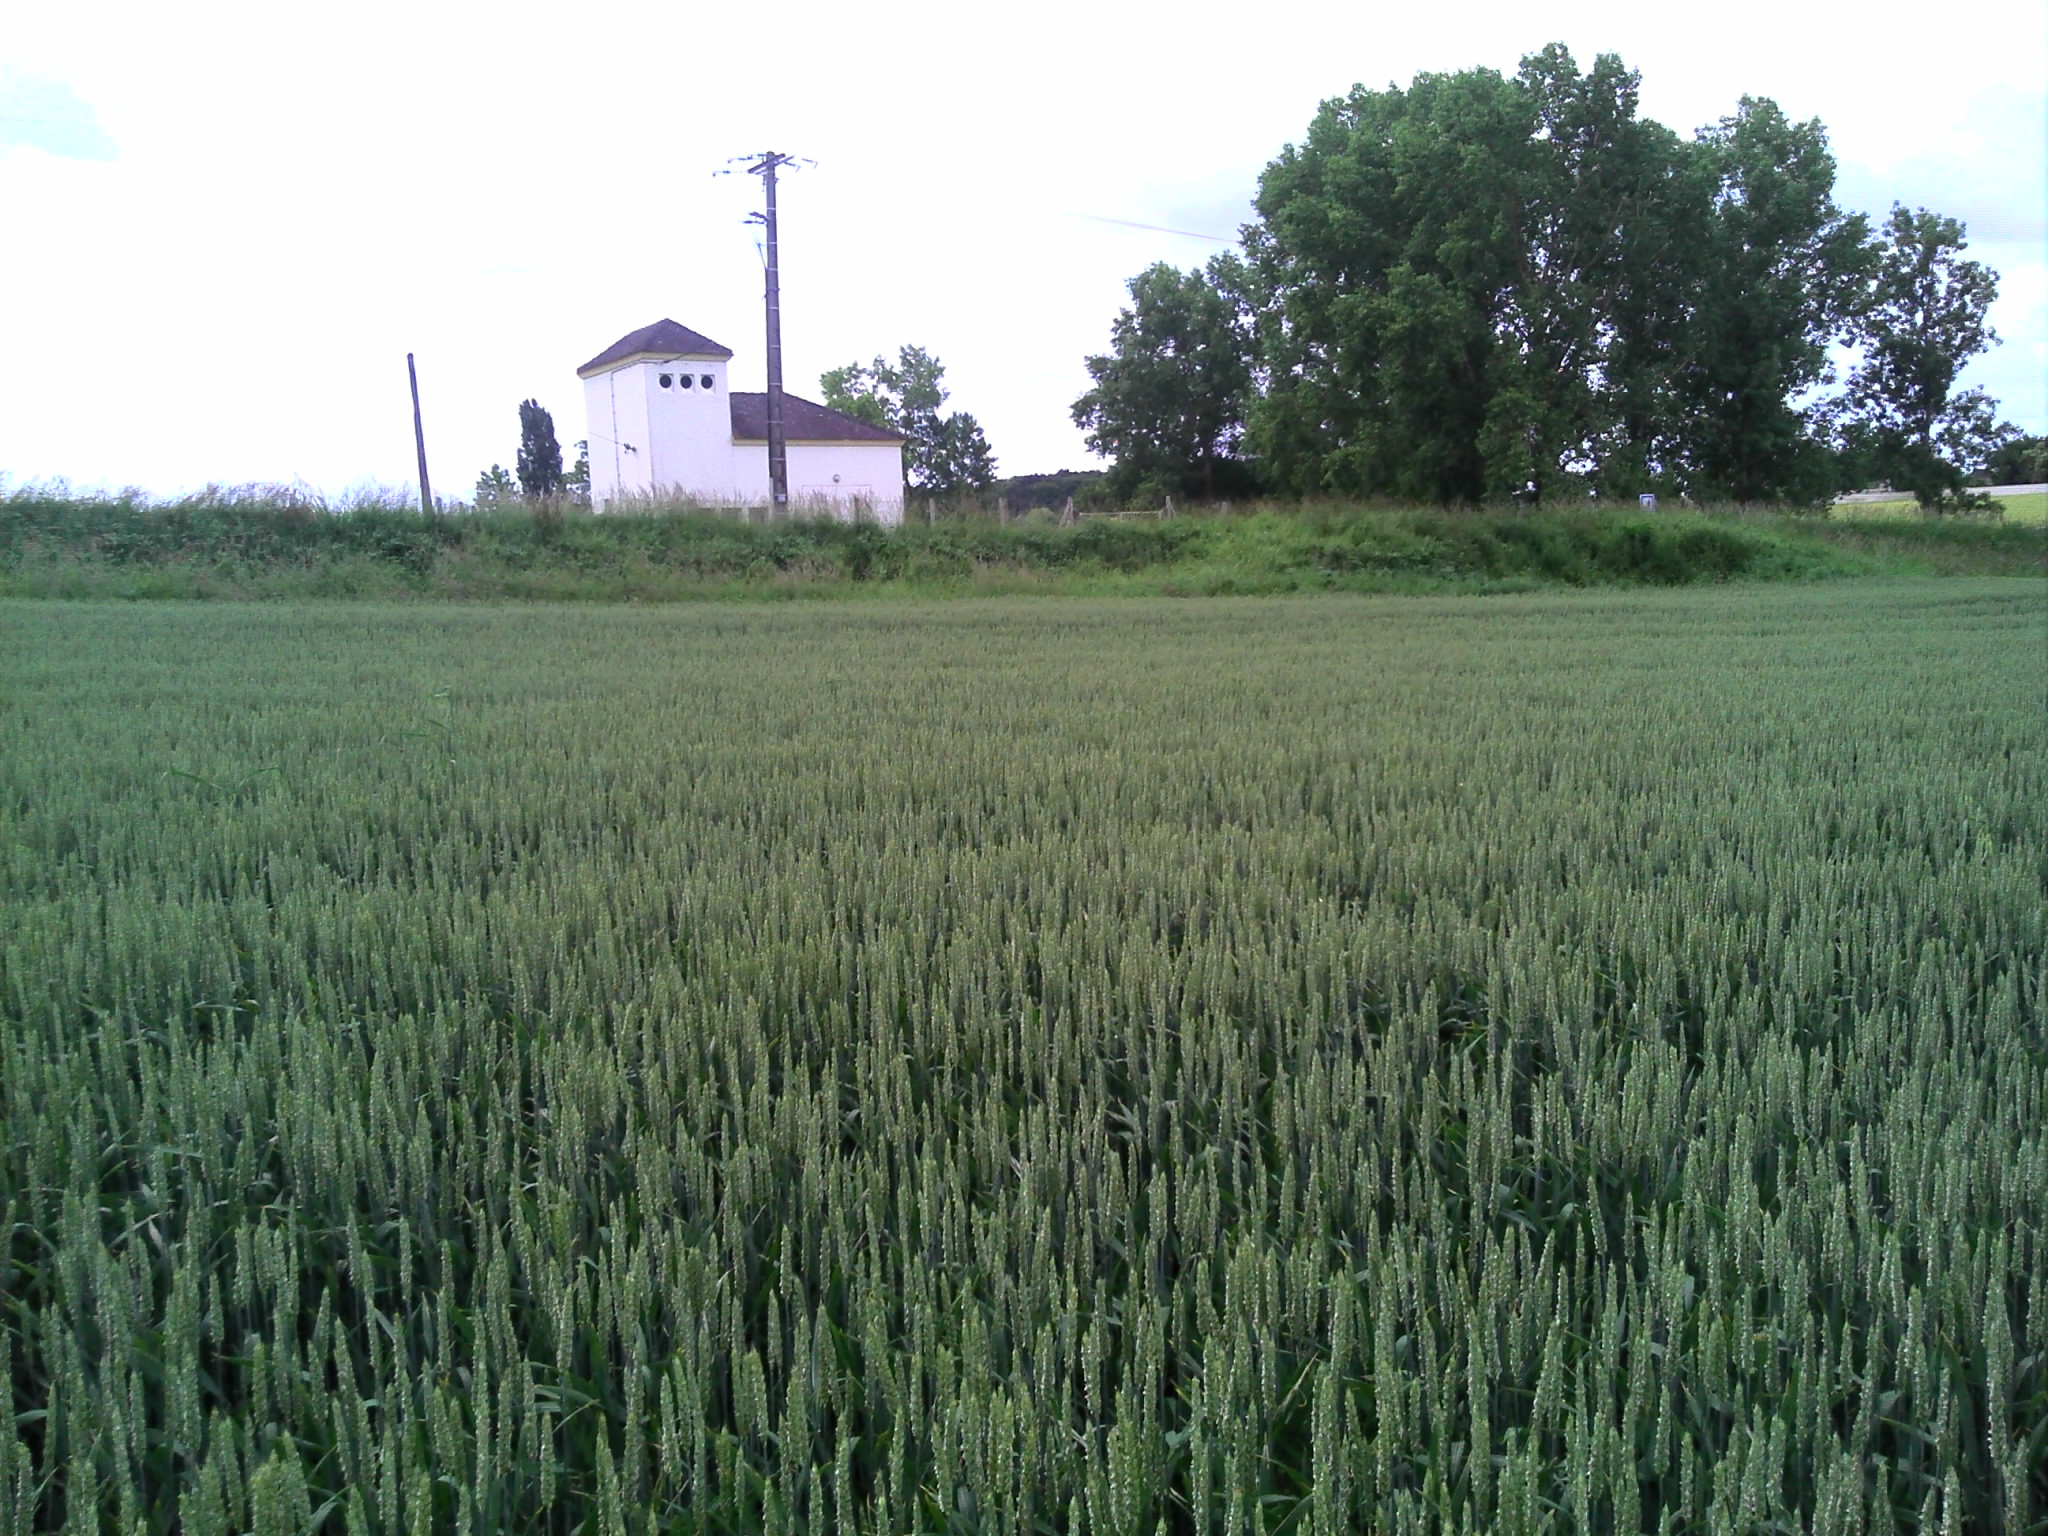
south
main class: Cropland
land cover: Common wheat
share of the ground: > 75 %
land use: Agriculture (excluding fallow land and kitchen gardens)
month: June
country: FR
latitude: 46.9347
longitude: 0.6163
